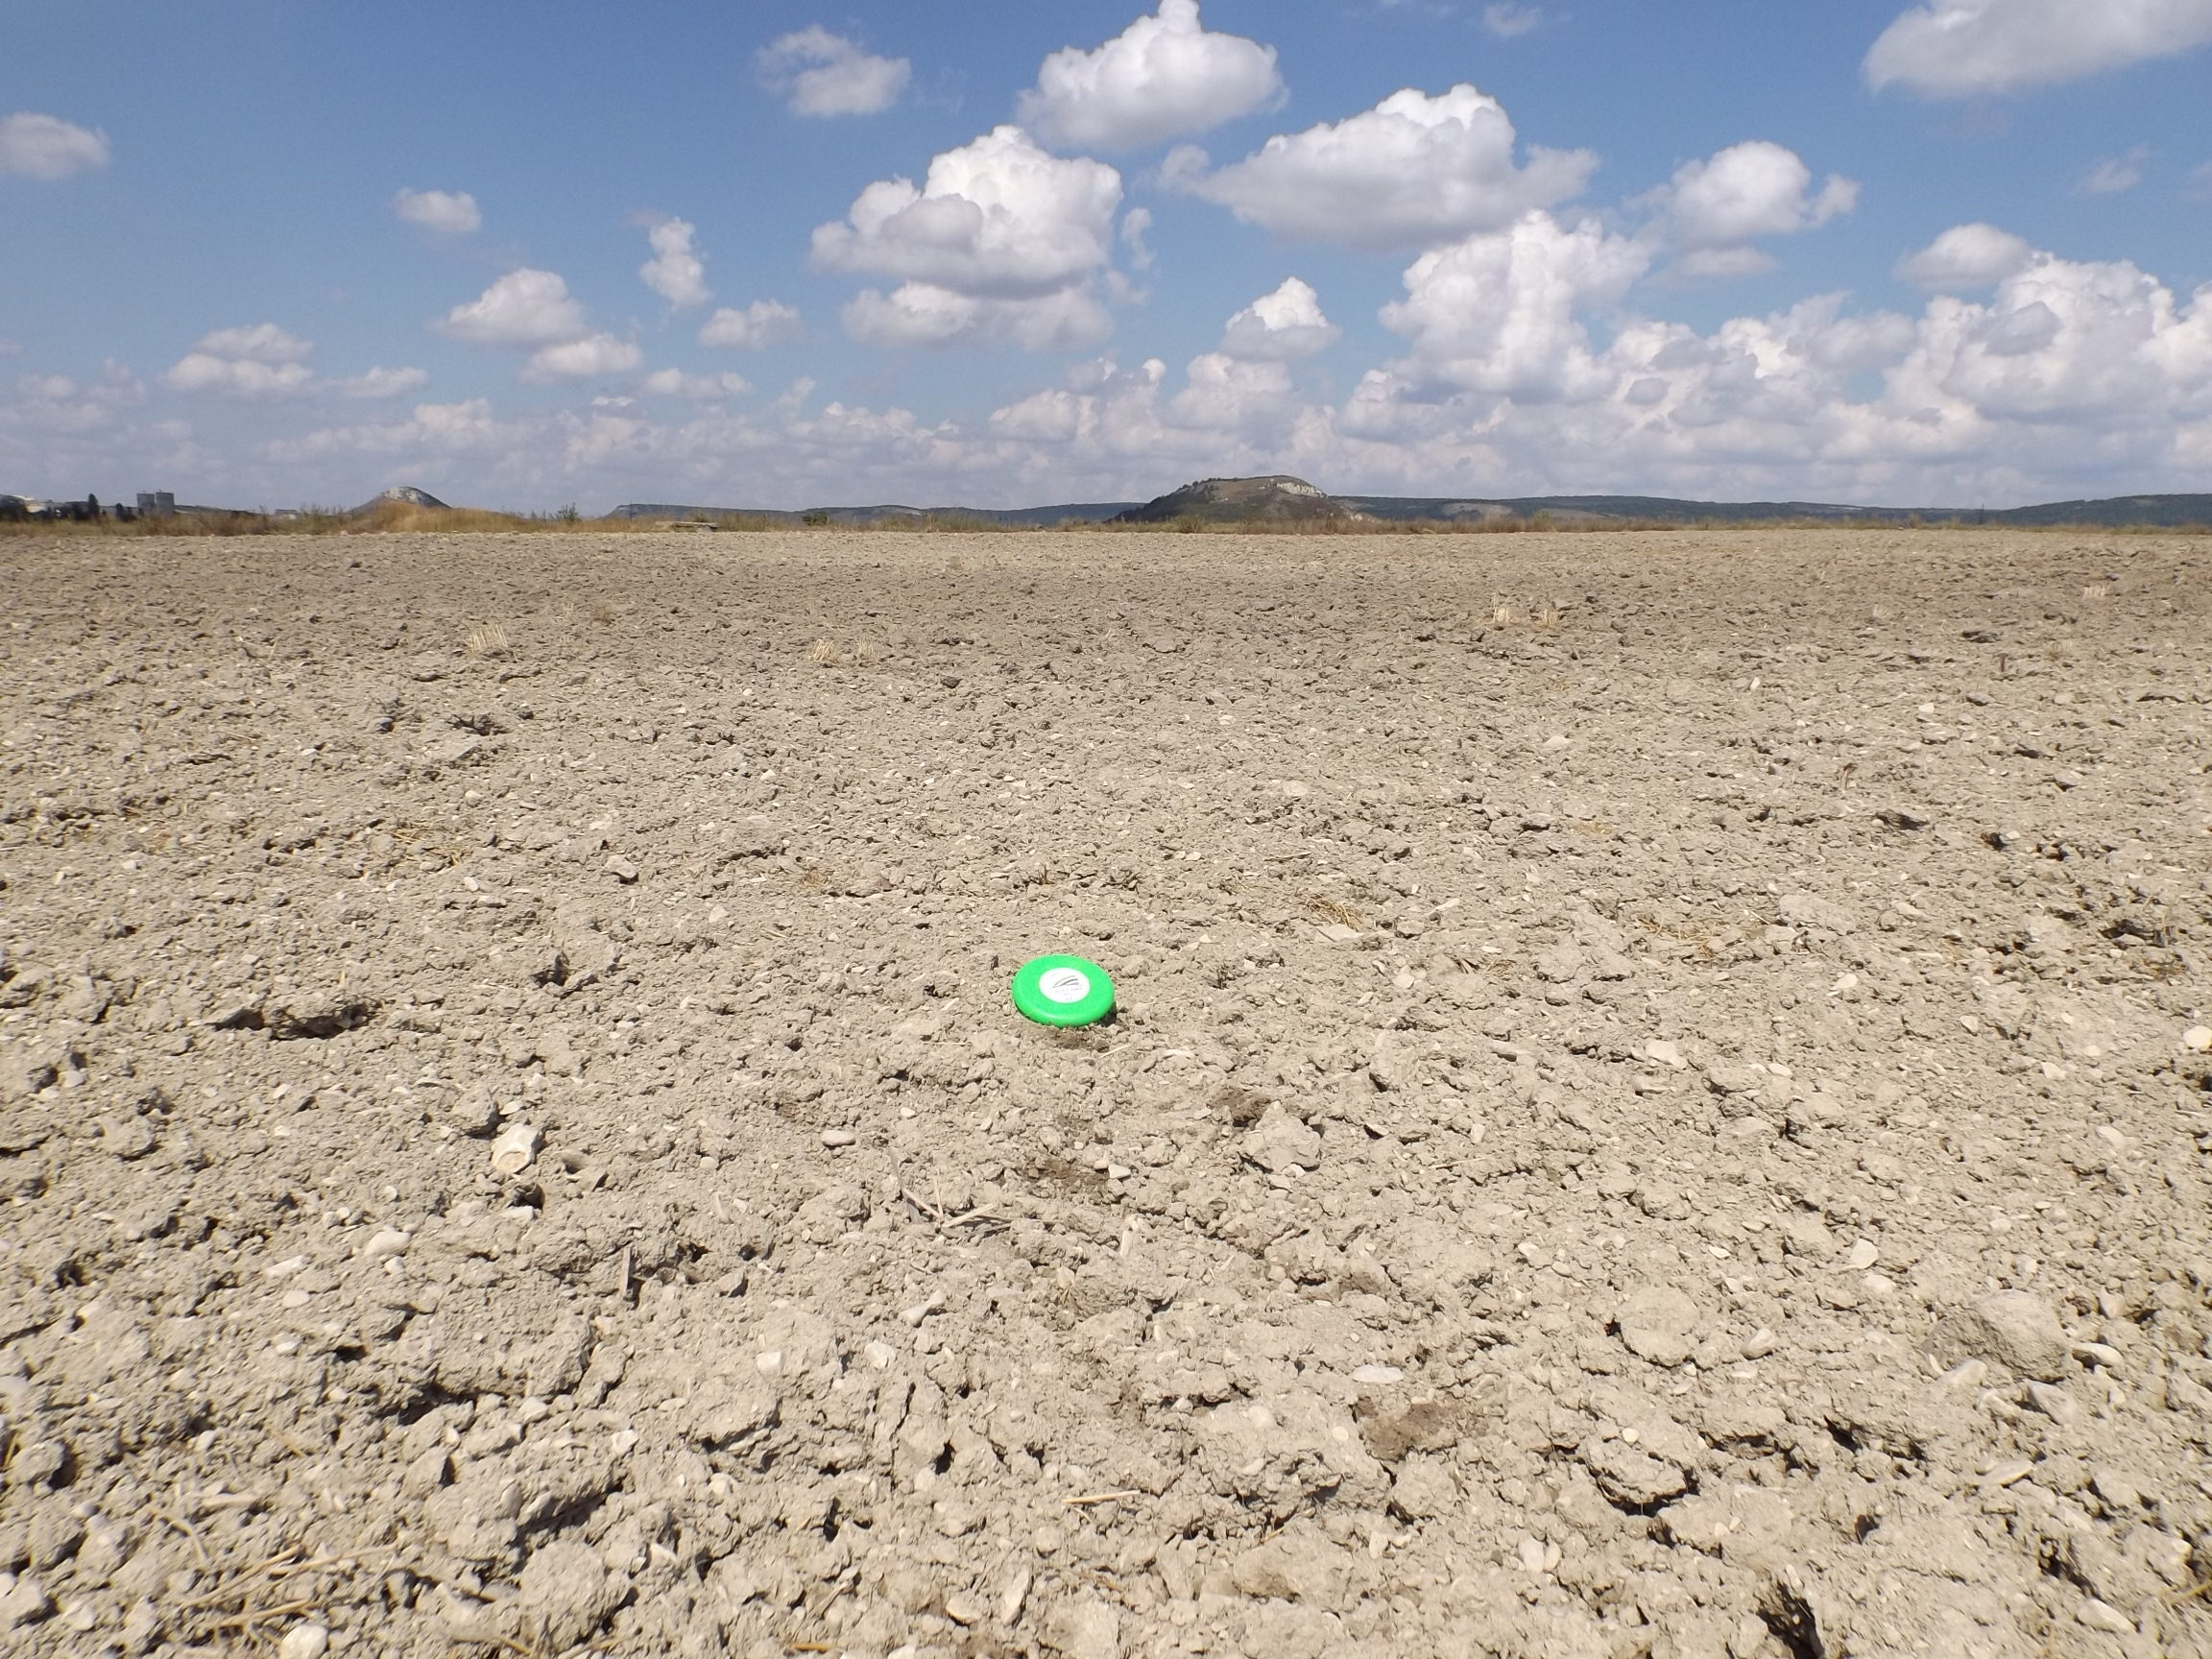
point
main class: Cropland
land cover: Common wheat
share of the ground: < 10 %
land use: Agriculture (excluding fallow land and kitchen gardens)
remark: Harvested field
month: August
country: BG
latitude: 43.2189
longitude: 27.5988
